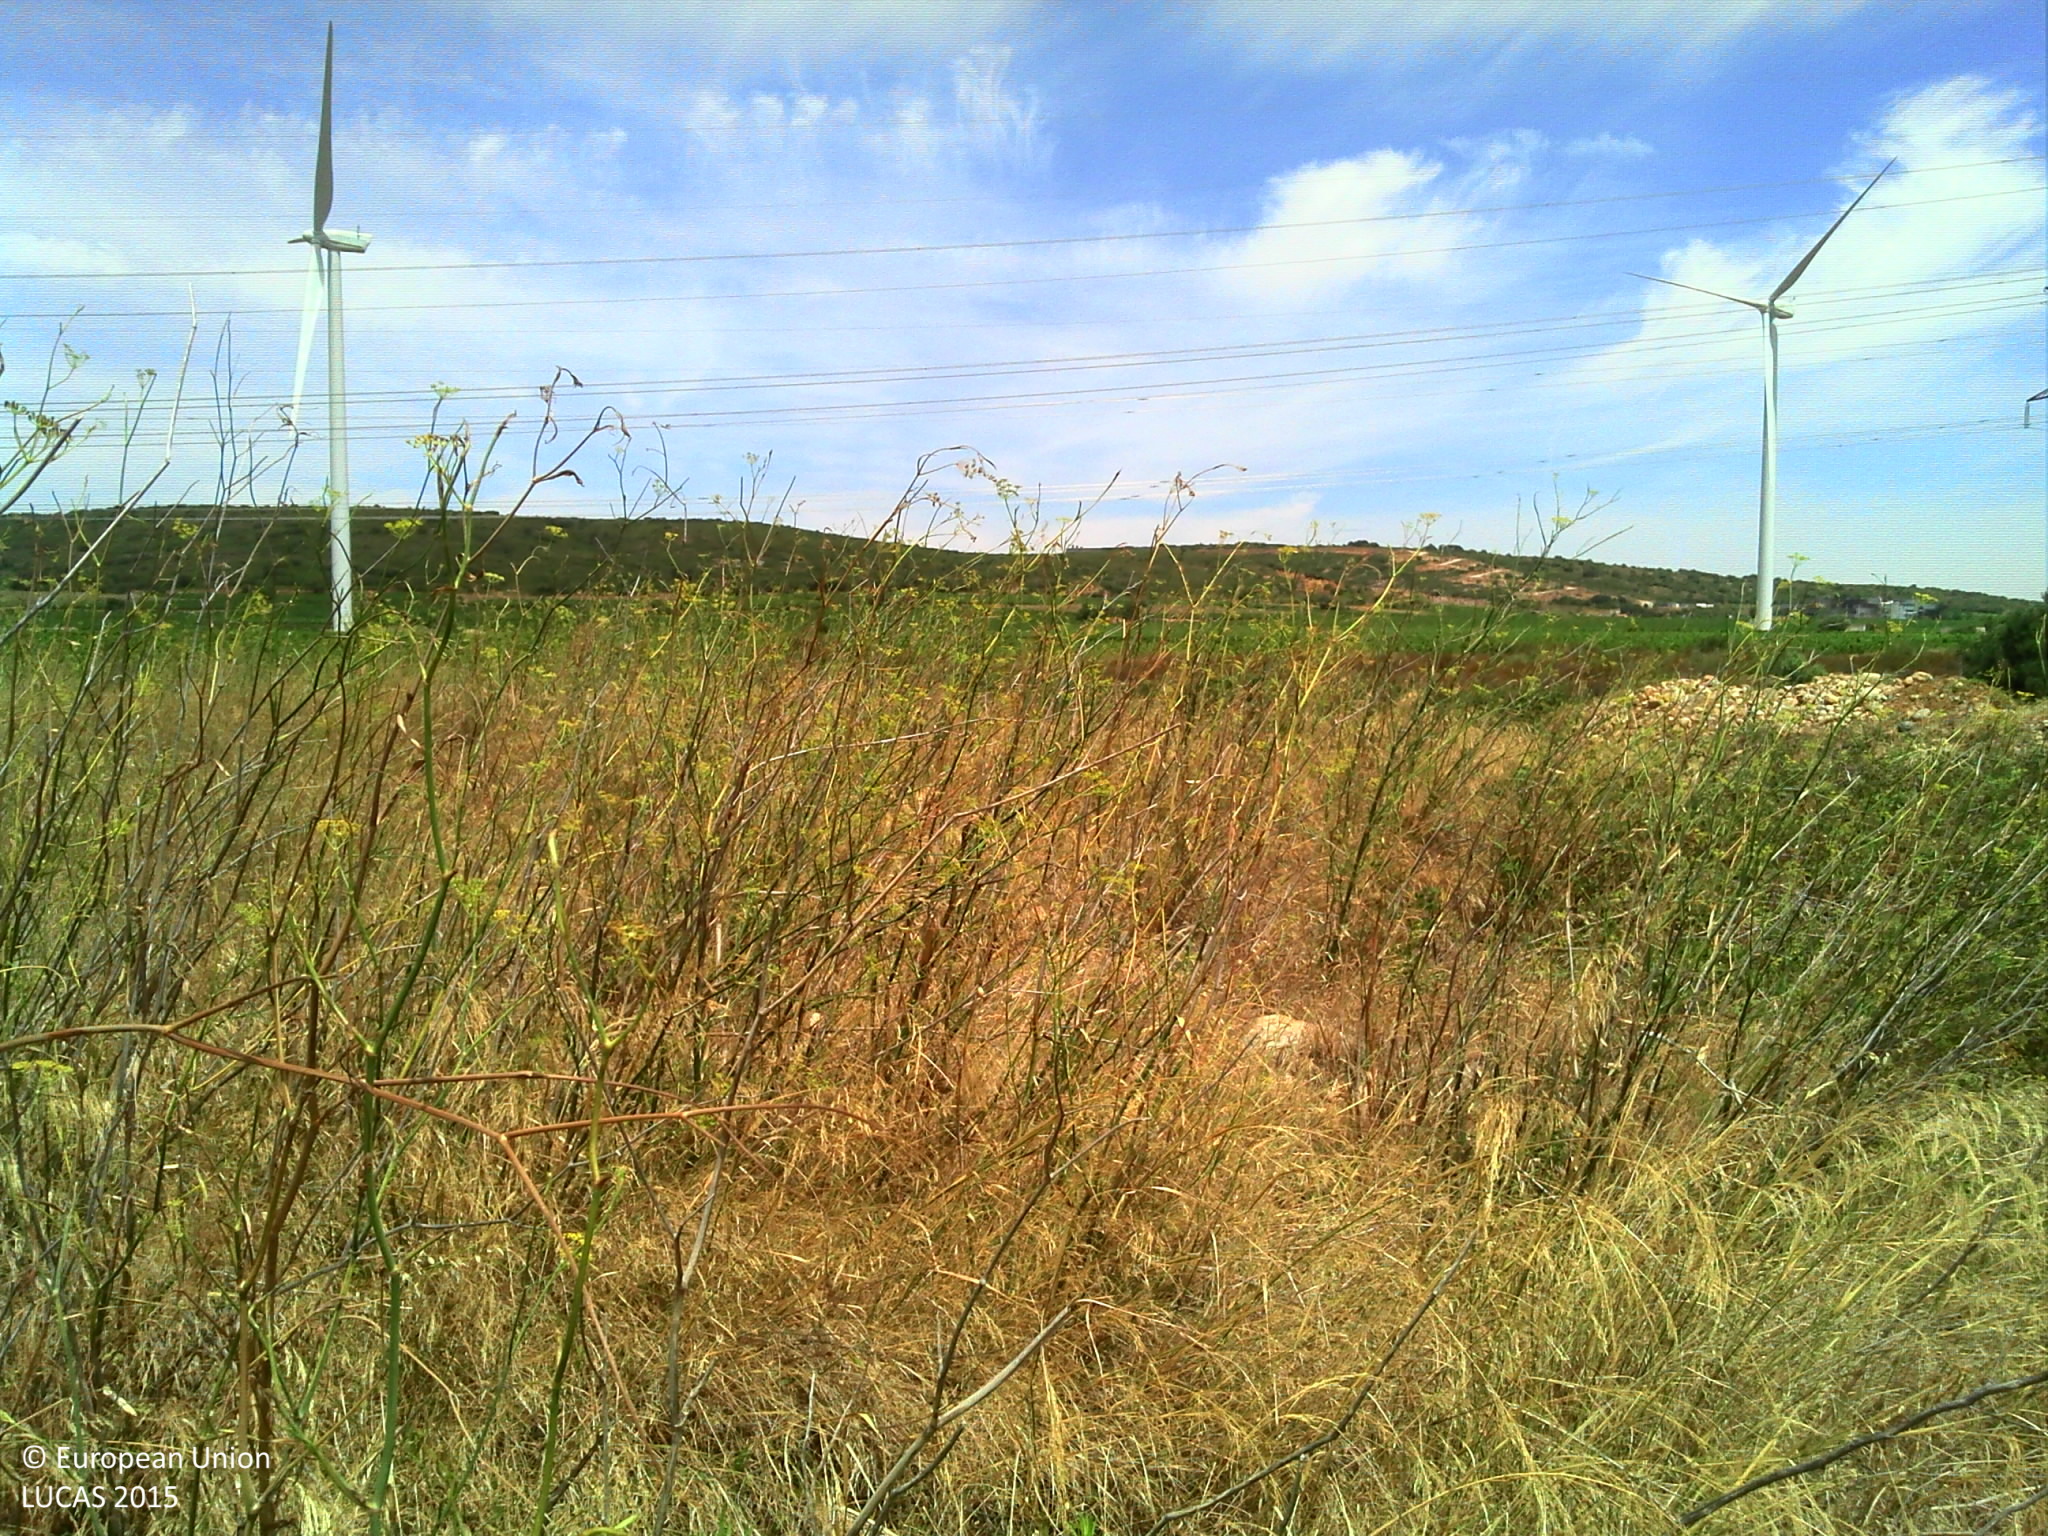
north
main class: Shrubland
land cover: Shrubland without tree cover
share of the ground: > 75 %
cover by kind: shrubs 60 %, herbaceous plants 40 %
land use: Energy production
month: July
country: FR
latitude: 42.7217
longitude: 2.7700
